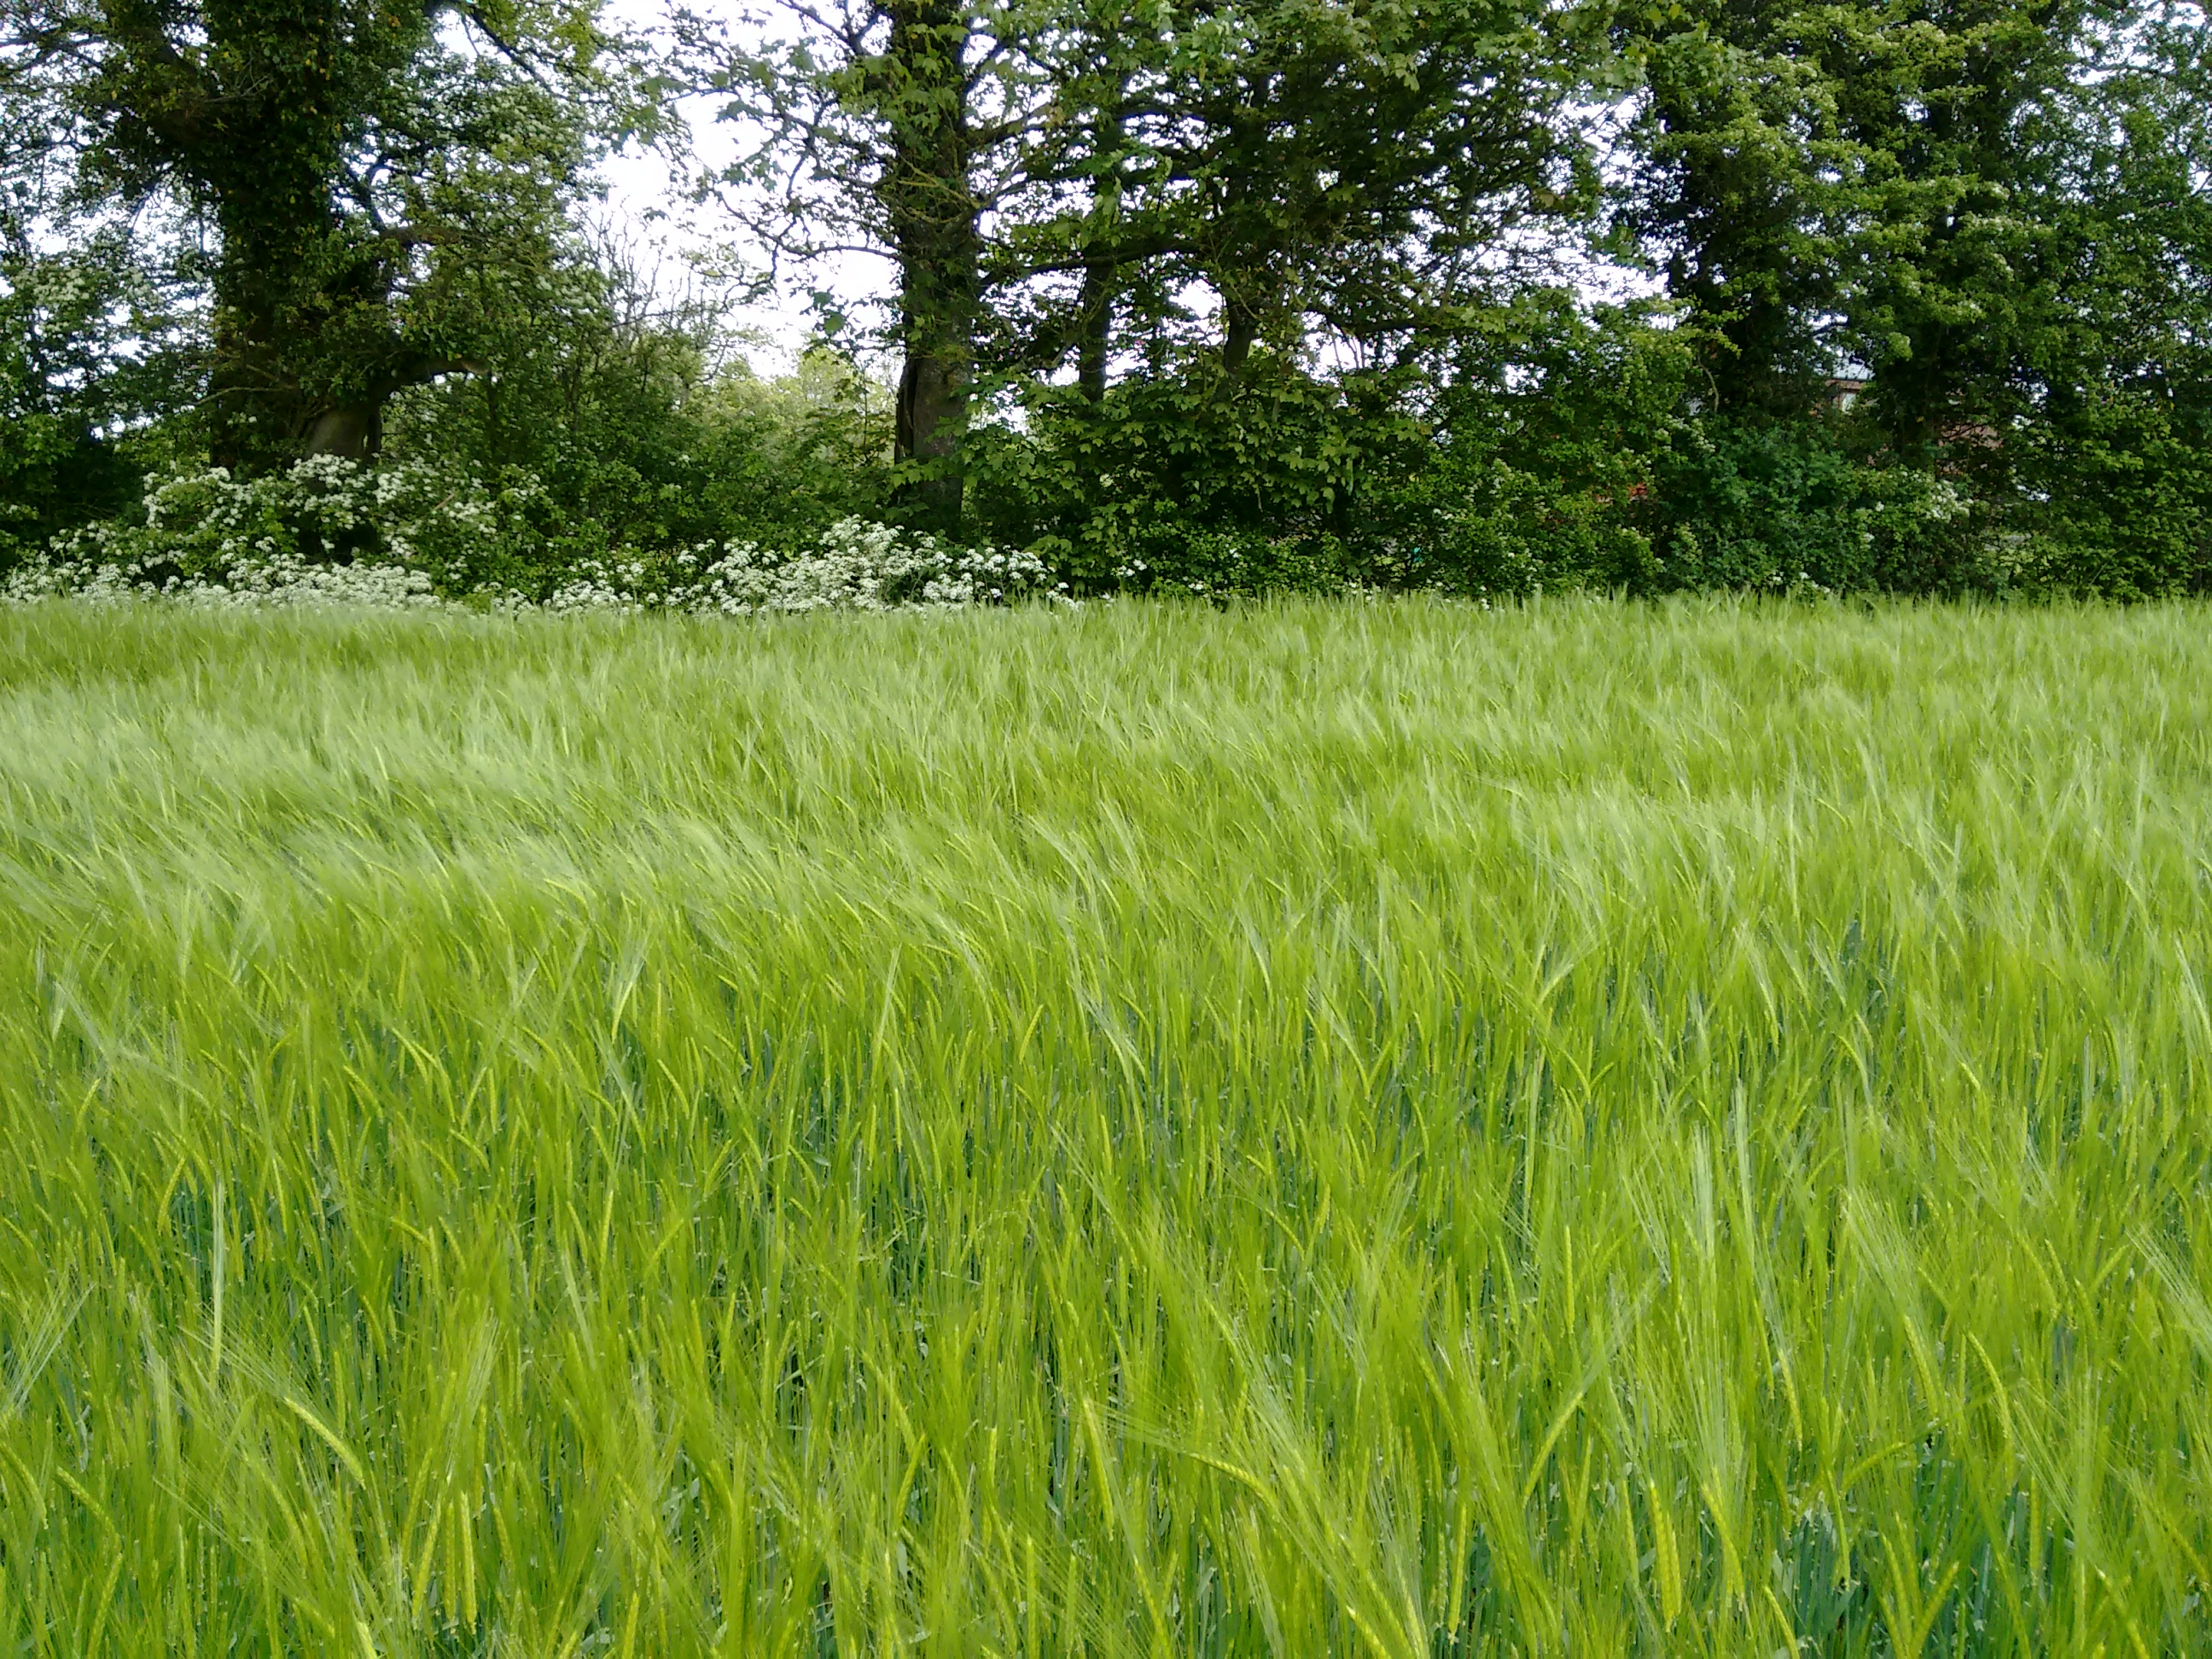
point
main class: Cropland
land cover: Barley
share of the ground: > 75 %
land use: Agriculture (excluding fallow land and kitchen gardens)
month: May
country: IE
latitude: 53.5419
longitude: -6.6551
